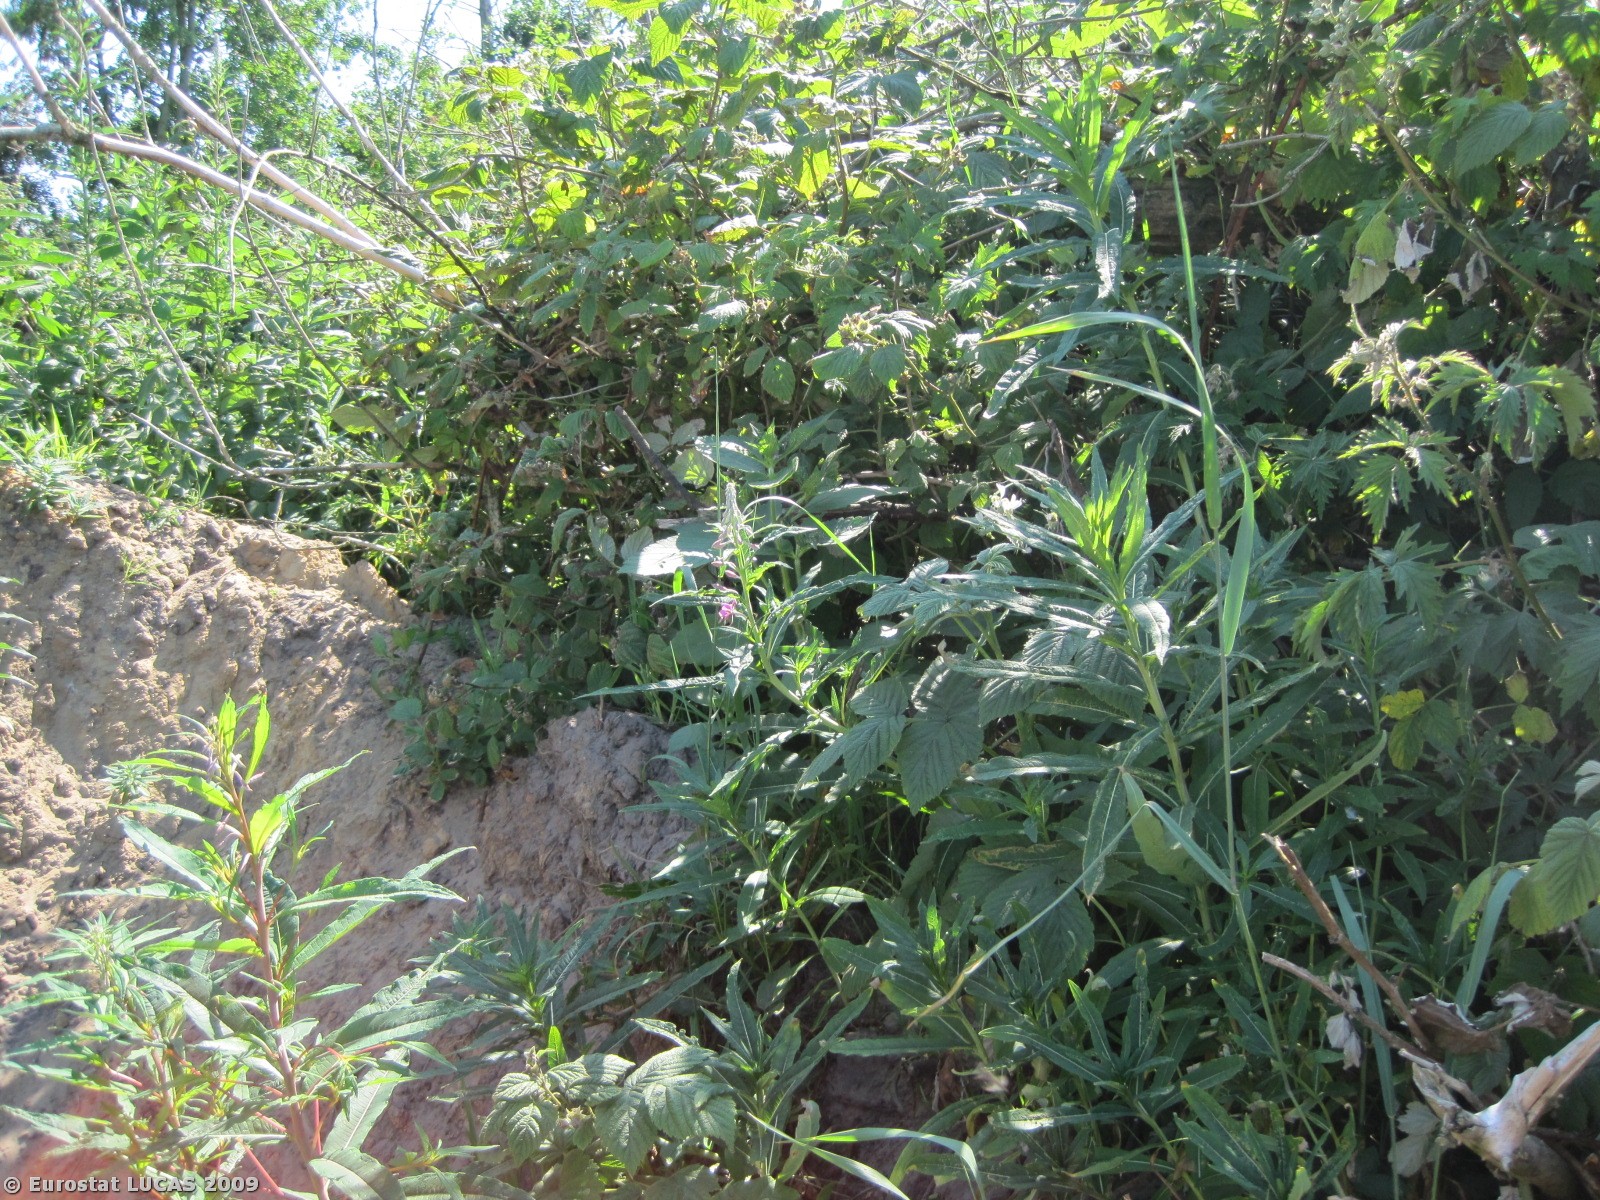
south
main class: Bare land
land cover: Bare land
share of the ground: > 75 %
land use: Unused
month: July
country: DK
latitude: 56.4107
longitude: 8.3326
